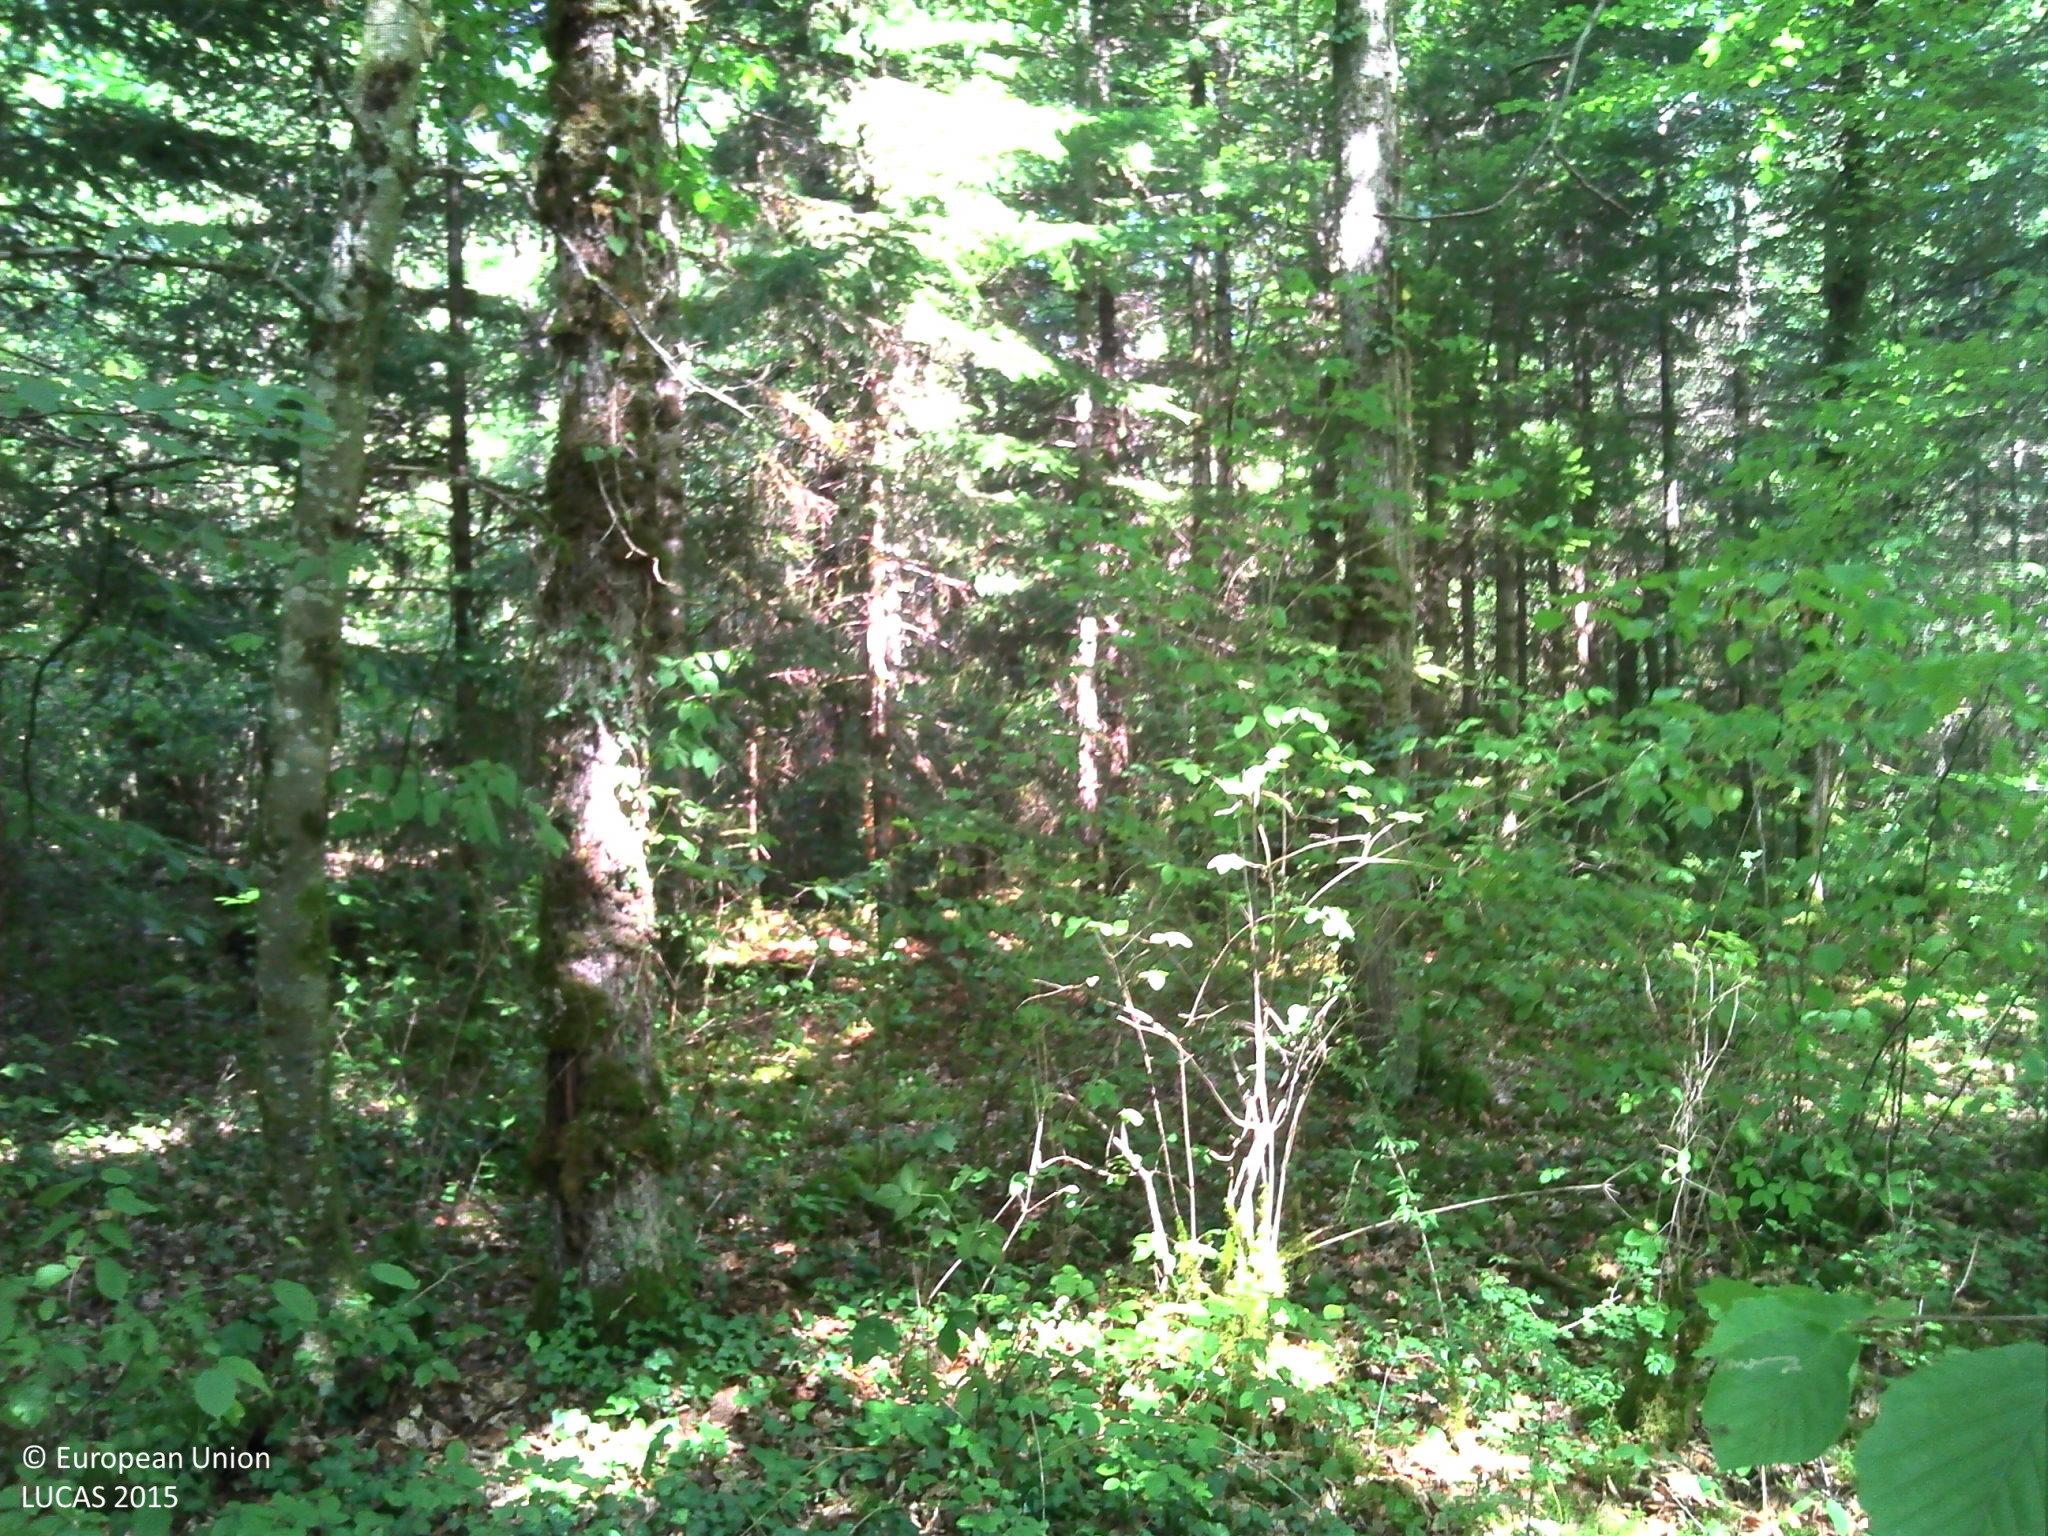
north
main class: Woodland
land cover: Pine dominated mixed woodland
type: acidophilous oak and oak-birch forest
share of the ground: > 75 %
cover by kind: coniferous forest trees 40 %, broadleaved forest trees 40 %, shrubs 10 %, herbaceous plants 10 %
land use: Forestry
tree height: > 5 m
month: August
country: FR
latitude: 47.3087
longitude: 4.8283
